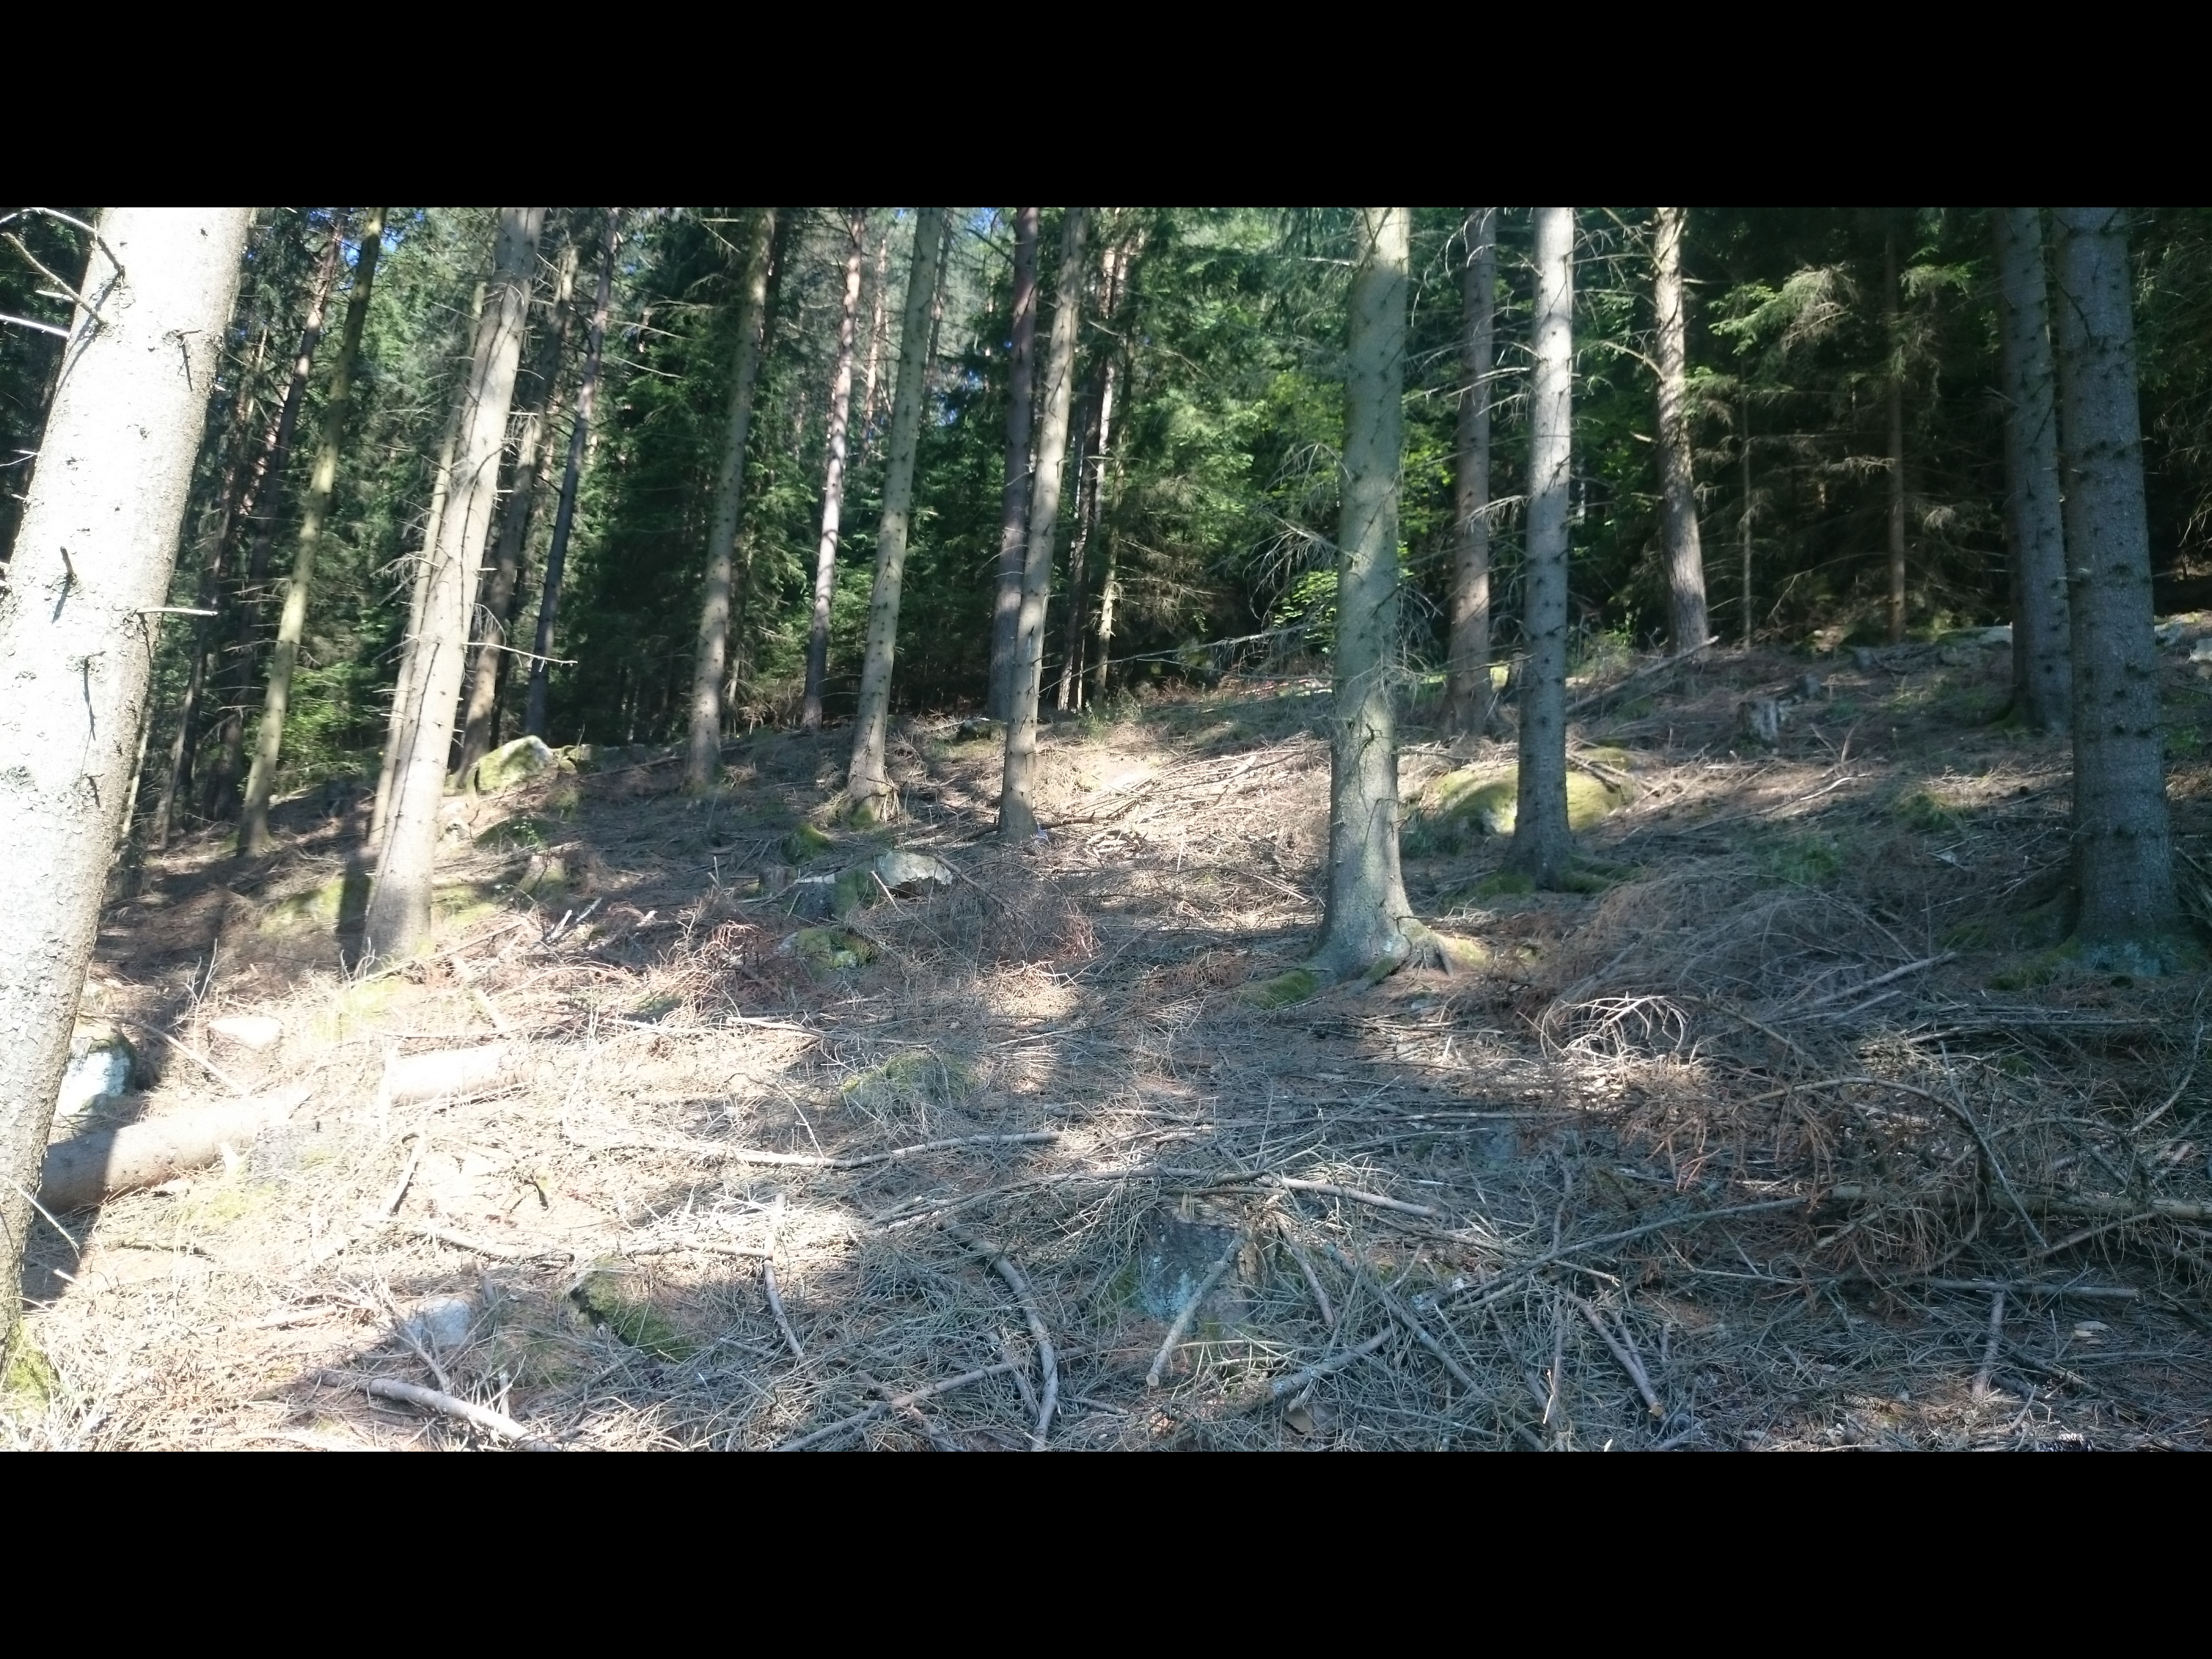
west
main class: Woodland
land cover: Spruce dominated coniferous woodland
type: hemiboreal forest and nemoral coniferous forest and mixed broadleaved-coniferous forest
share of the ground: > 75 %
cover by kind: coniferous forest trees 75 %, unconsolidated bare surface 25 %
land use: Forestry
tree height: > 5 m
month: June
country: AT
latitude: 48.4695
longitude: 14.6131
